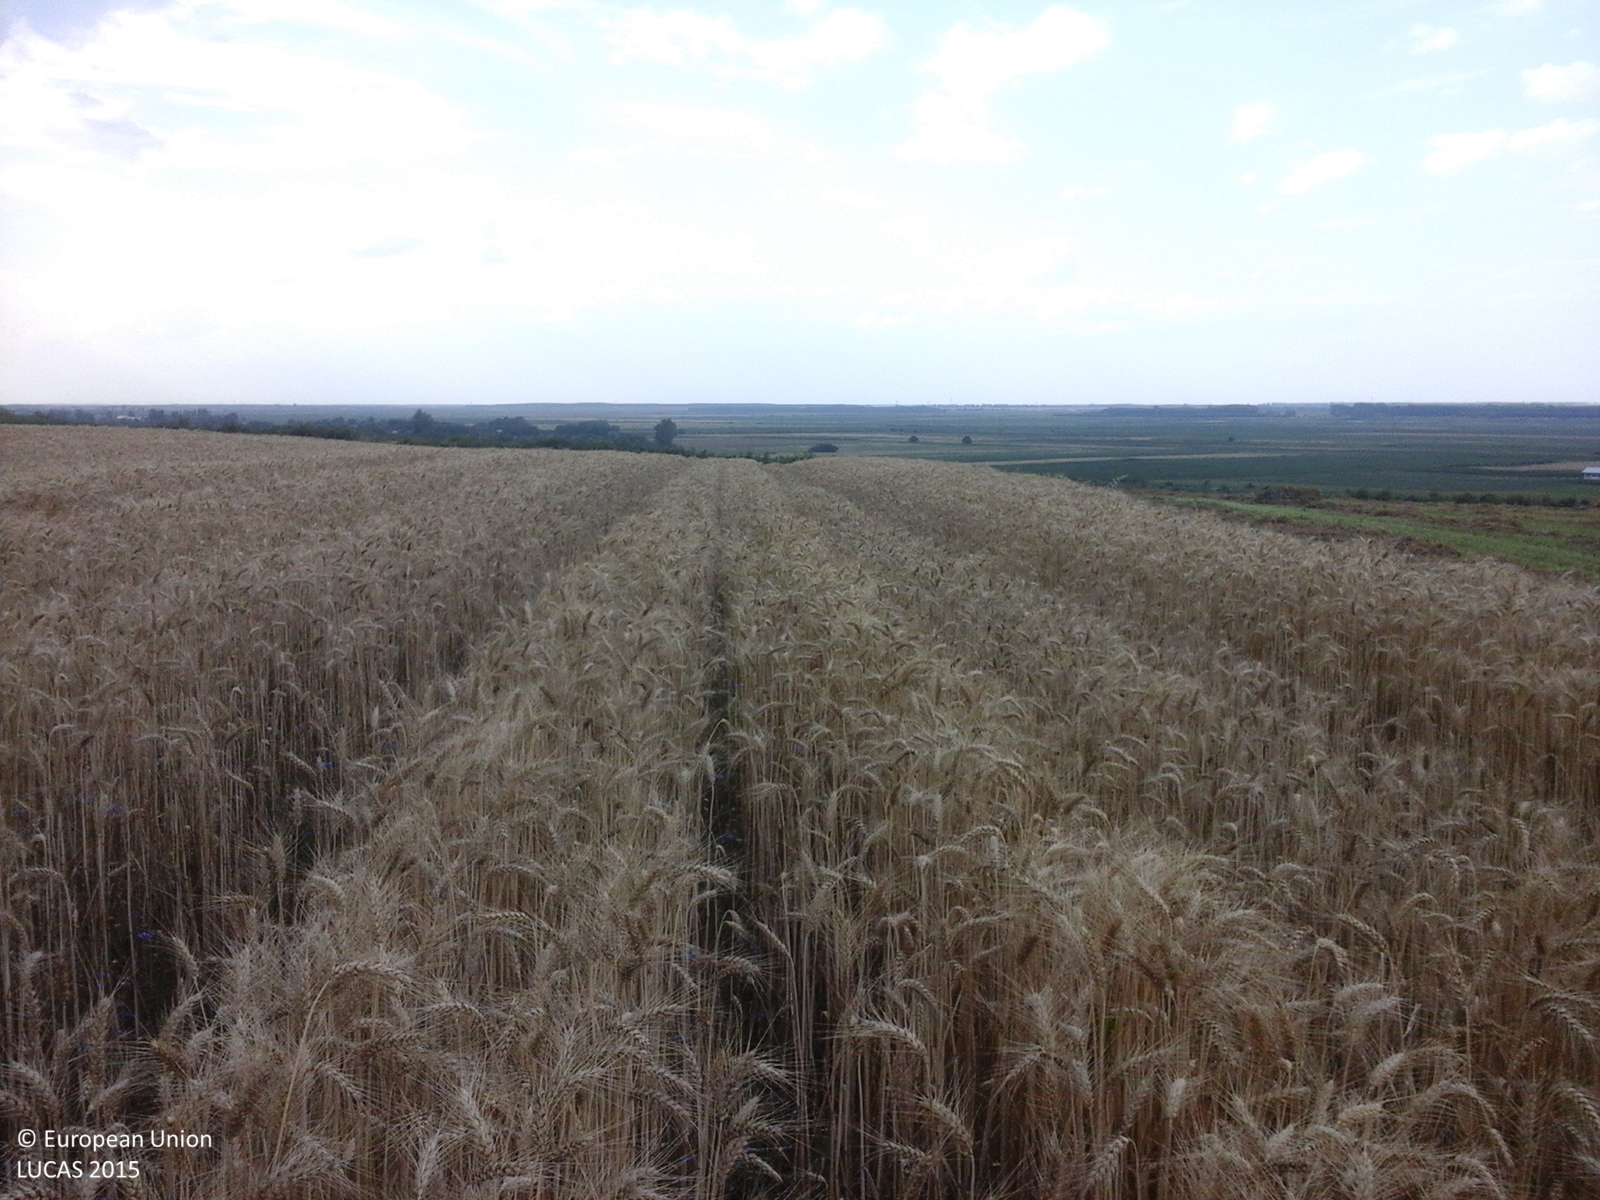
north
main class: Cropland
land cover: Common wheat
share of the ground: > 75 %
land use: Agriculture (excluding fallow land and kitchen gardens)
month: June
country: RO
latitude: 44.1494
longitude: 26.5538
